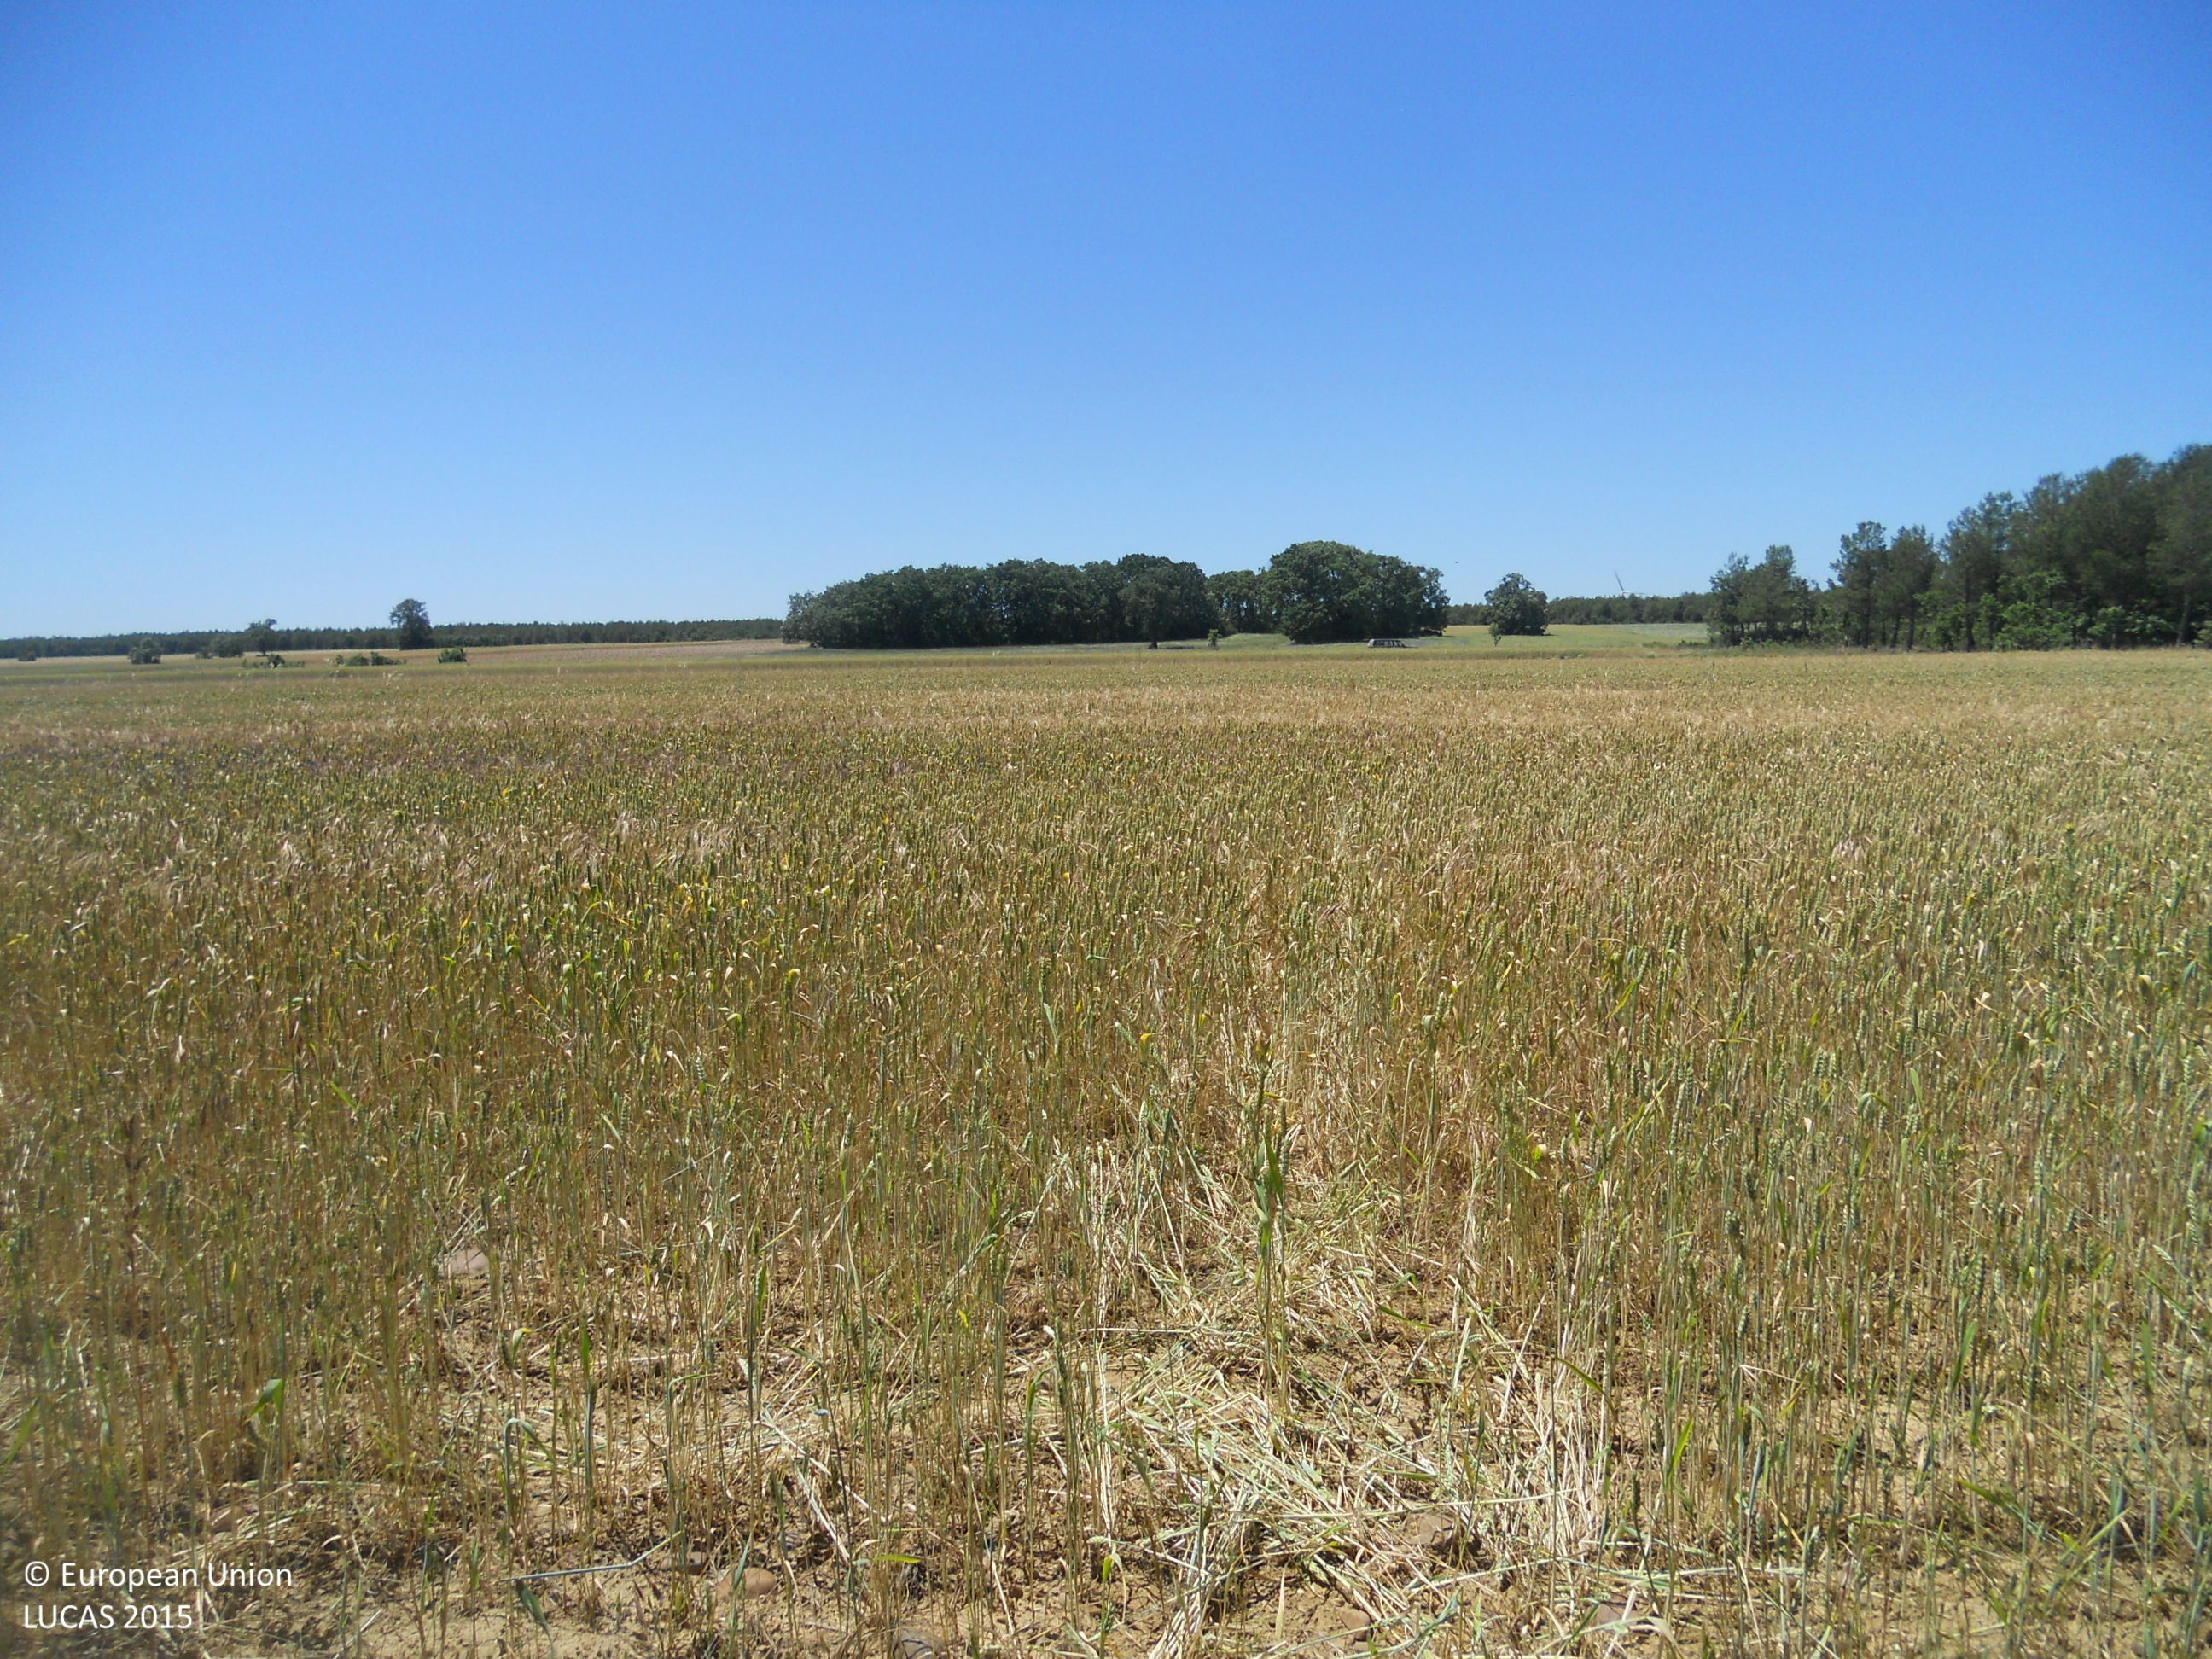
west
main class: Woodland
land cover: Pine dominated coniferous woodland
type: coniferous forest of the mediterranean region
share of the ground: > 75 %
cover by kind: coniferous forest trees 60 %, broadleaved forest trees 20 %, shrubs 10 %, herbaceous plants 10 %
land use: Forestry
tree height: > 5 m
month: June
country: ES
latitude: 42.4676
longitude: -4.8586
